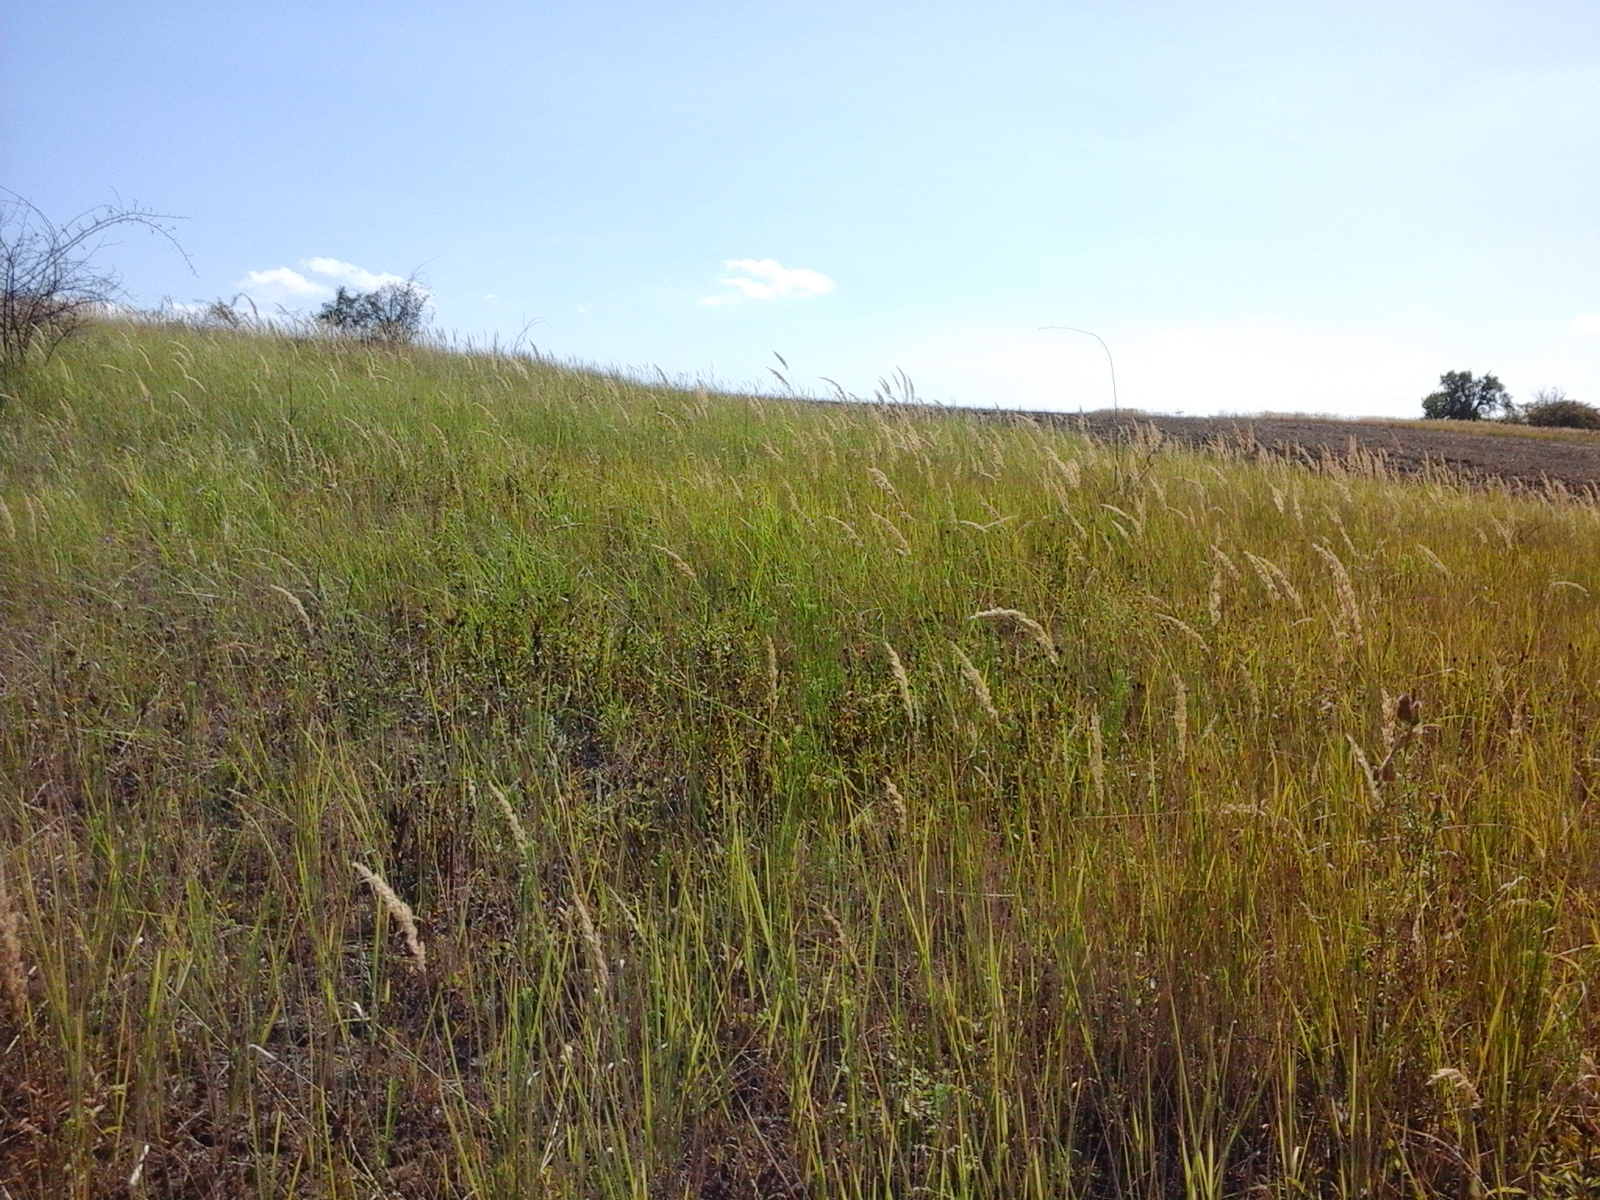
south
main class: Grassland
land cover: Grassland with sparse tree/shrub cover
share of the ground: > 75 %
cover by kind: herbaceous plants 95 %, broadleaved forest trees 5 %
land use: Agriculture (excluding fallow land and kitchen gardens)
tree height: < 5 m
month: August
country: RO
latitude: 45.2039
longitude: 21.4754
